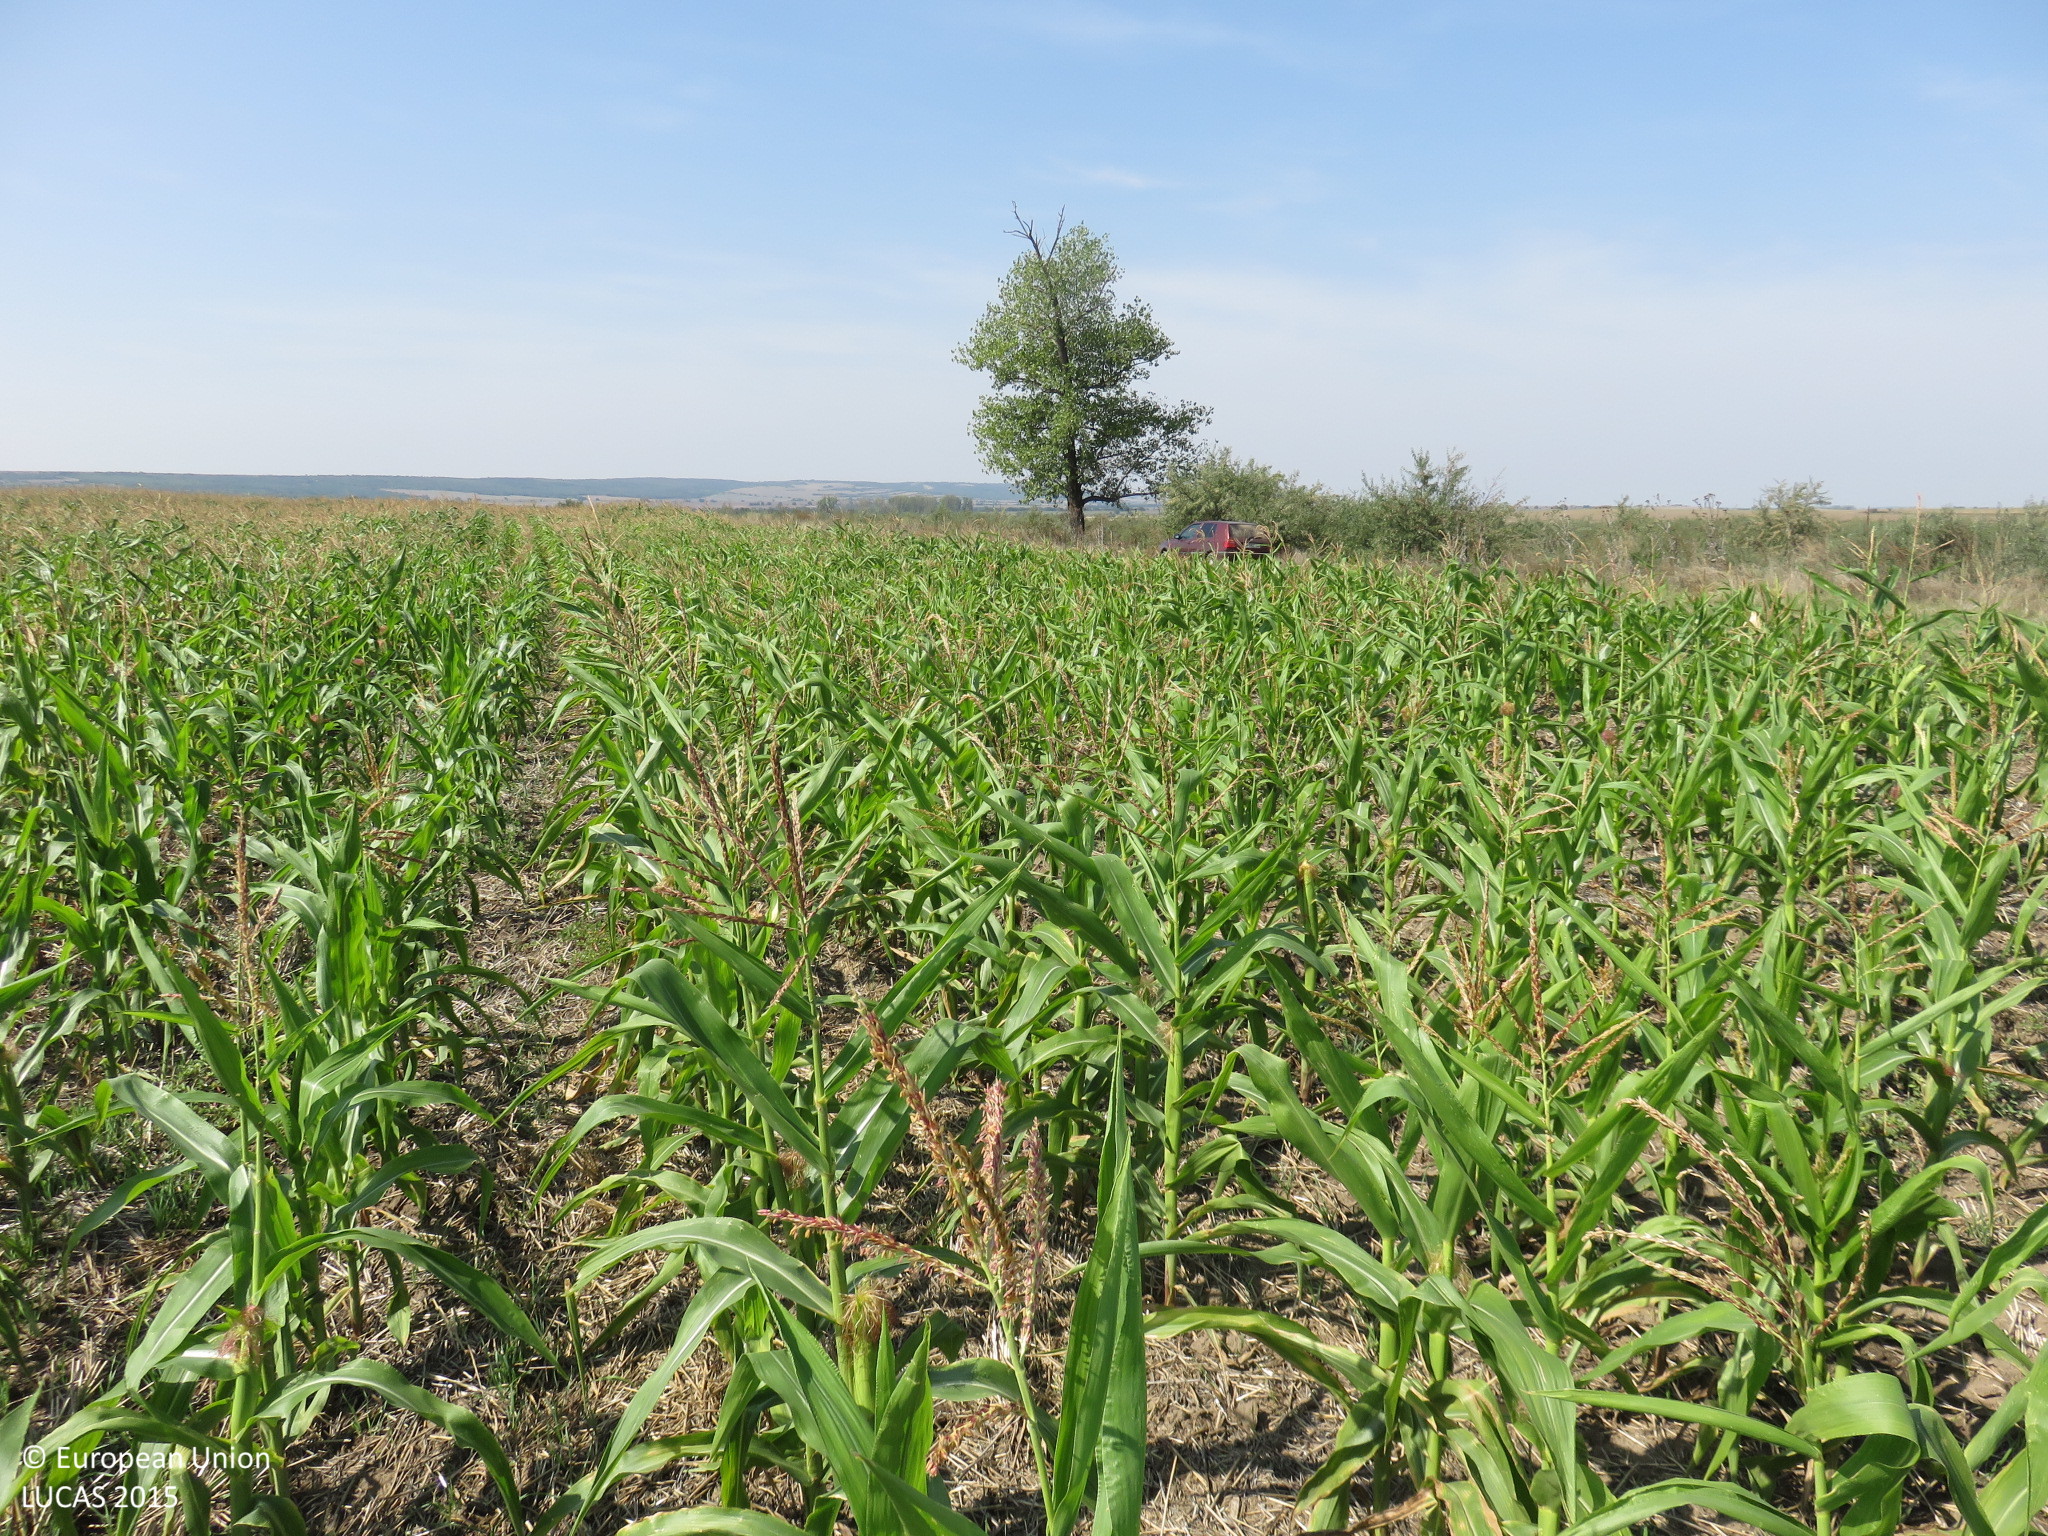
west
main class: Cropland
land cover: Maize
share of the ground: 50 - 75 %
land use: Agriculture (excluding fallow land and kitchen gardens)
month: September
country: BG
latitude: 43.6578
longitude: 24.6102
